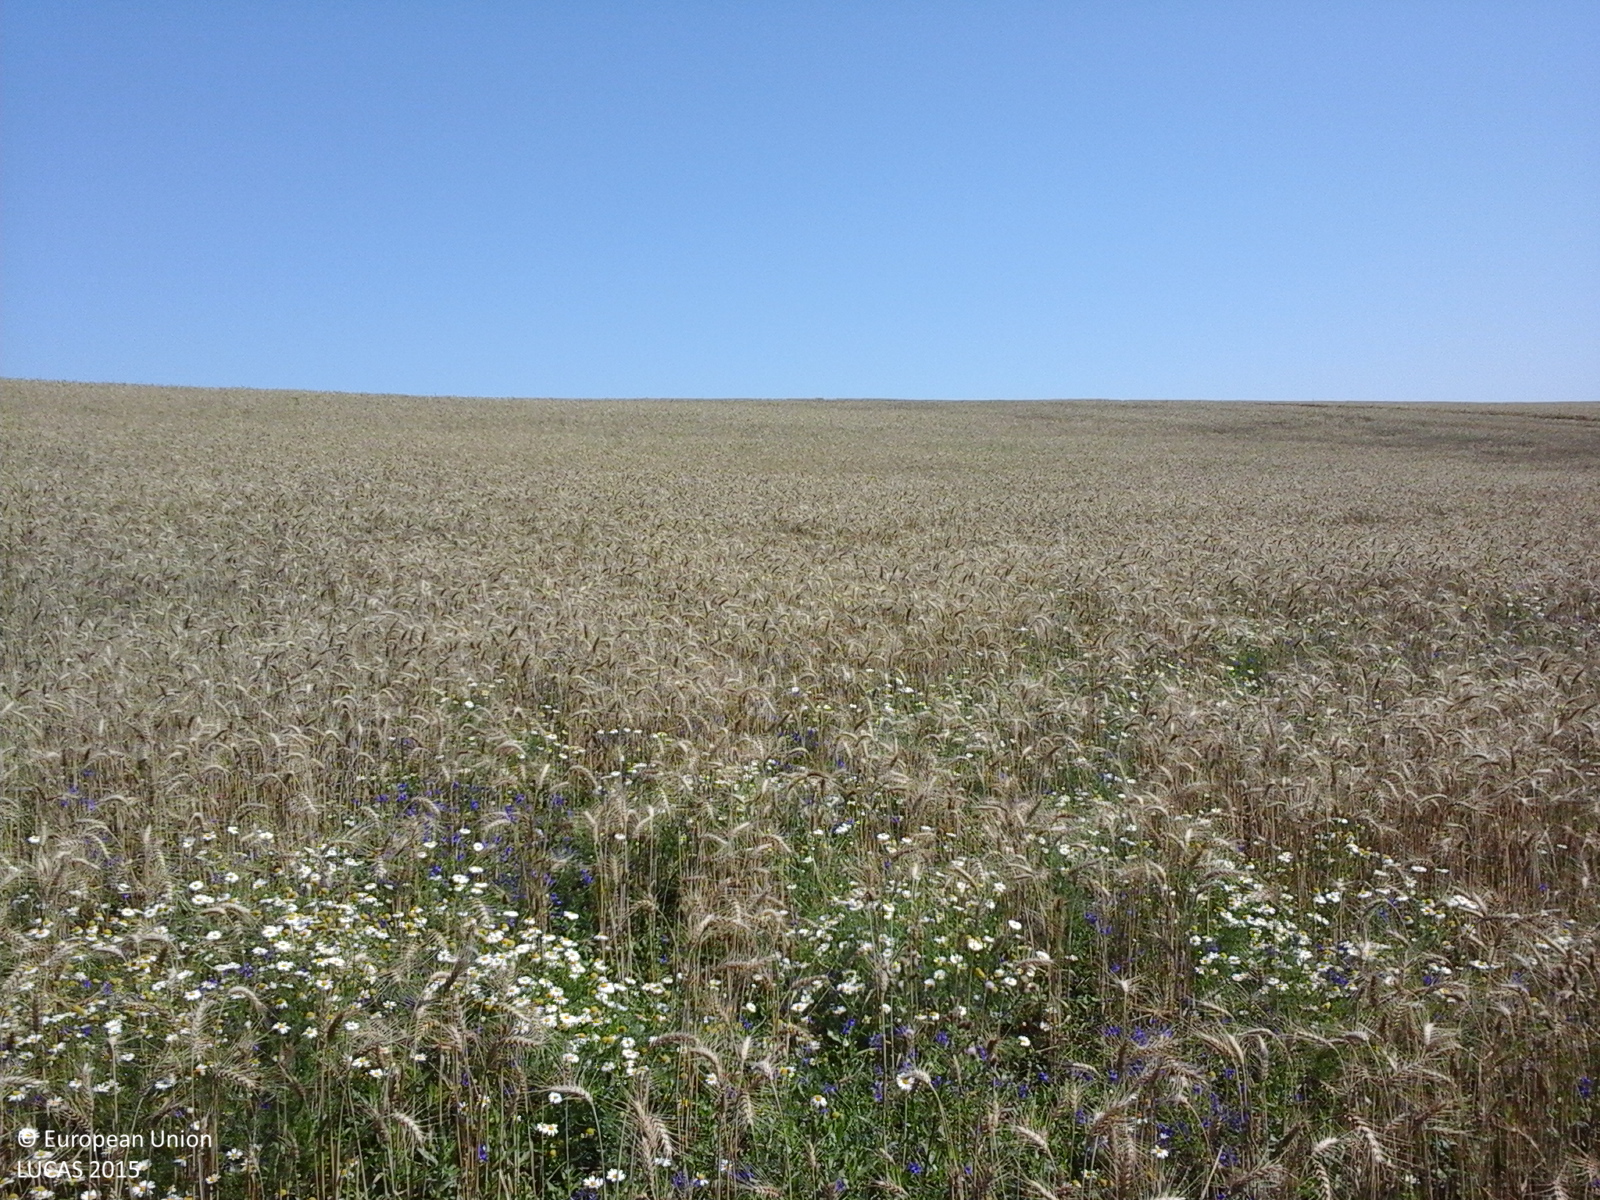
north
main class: Cropland
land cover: Common wheat
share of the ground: > 75 %
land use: Agriculture (excluding fallow land and kitchen gardens)
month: July
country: RO
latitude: 44.1730
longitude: 24.8459
